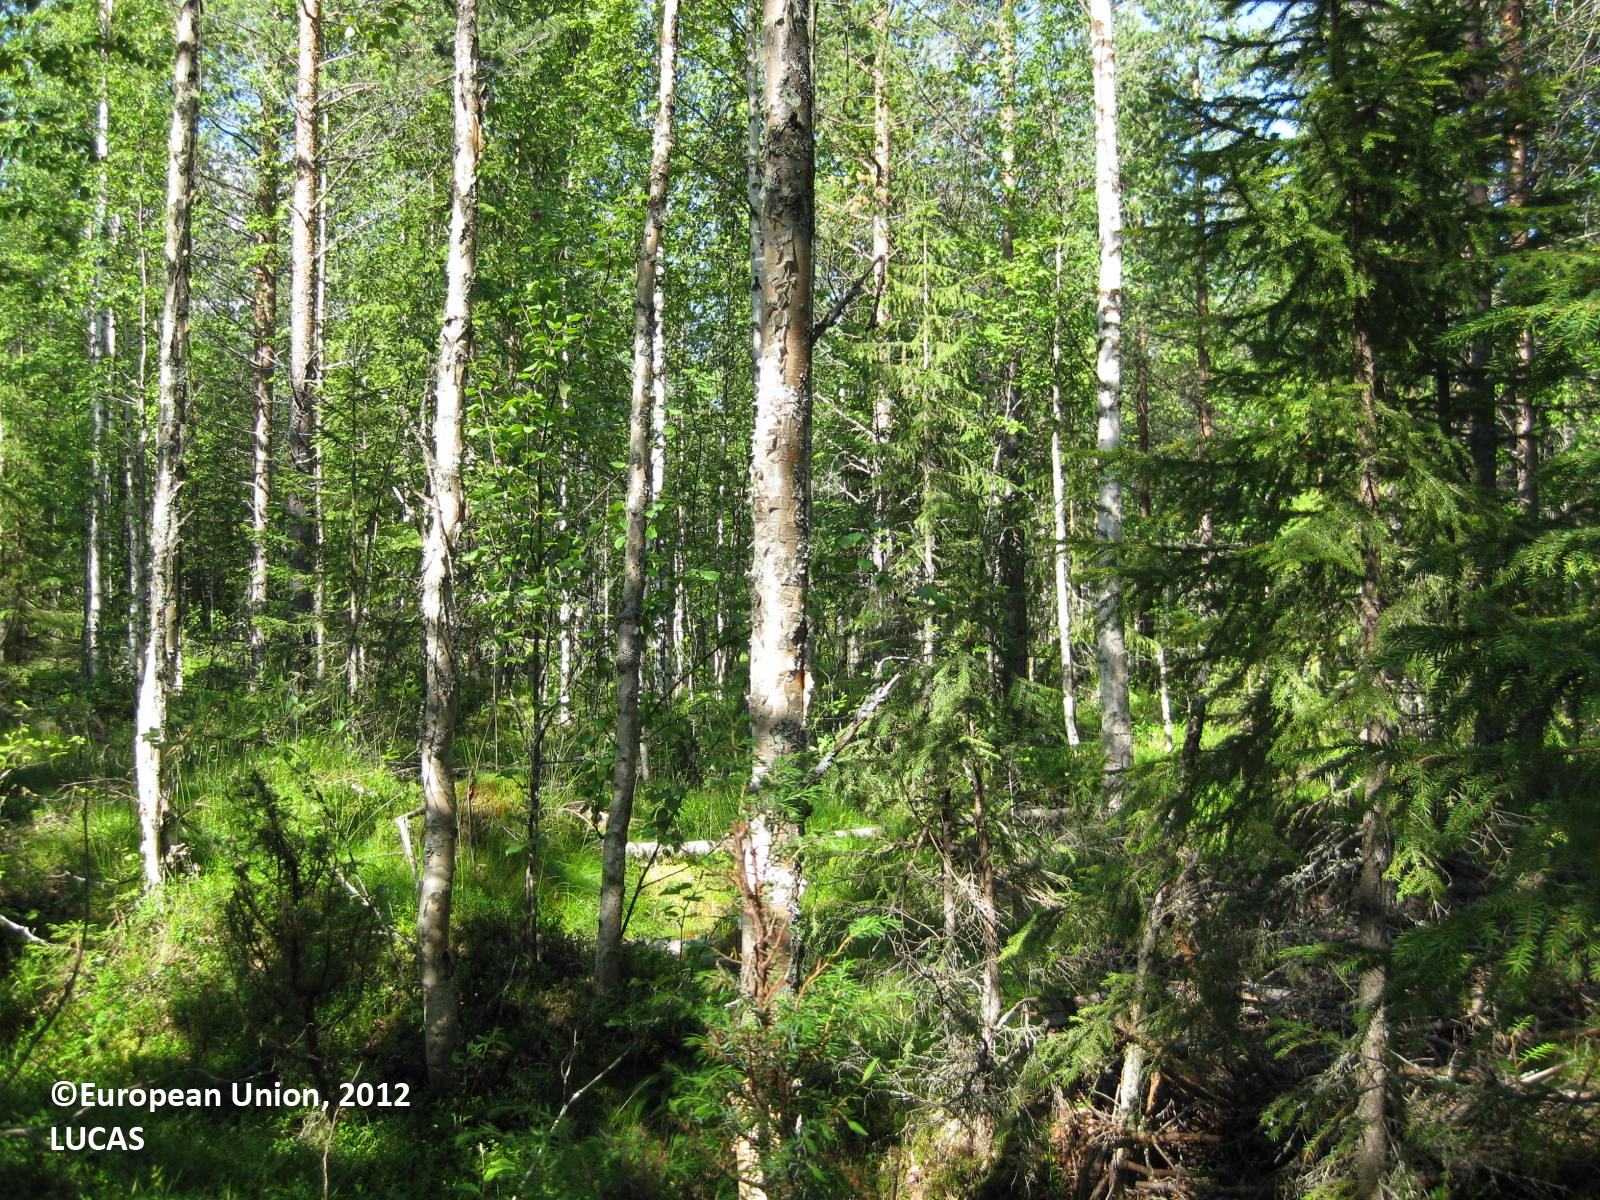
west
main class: Woodland
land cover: Pine dominated mixed woodland
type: boreal forest
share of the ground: 50 - 75 %
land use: Forestry
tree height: > 5 m
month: July
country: FI
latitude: 65.5775
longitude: 28.4753
